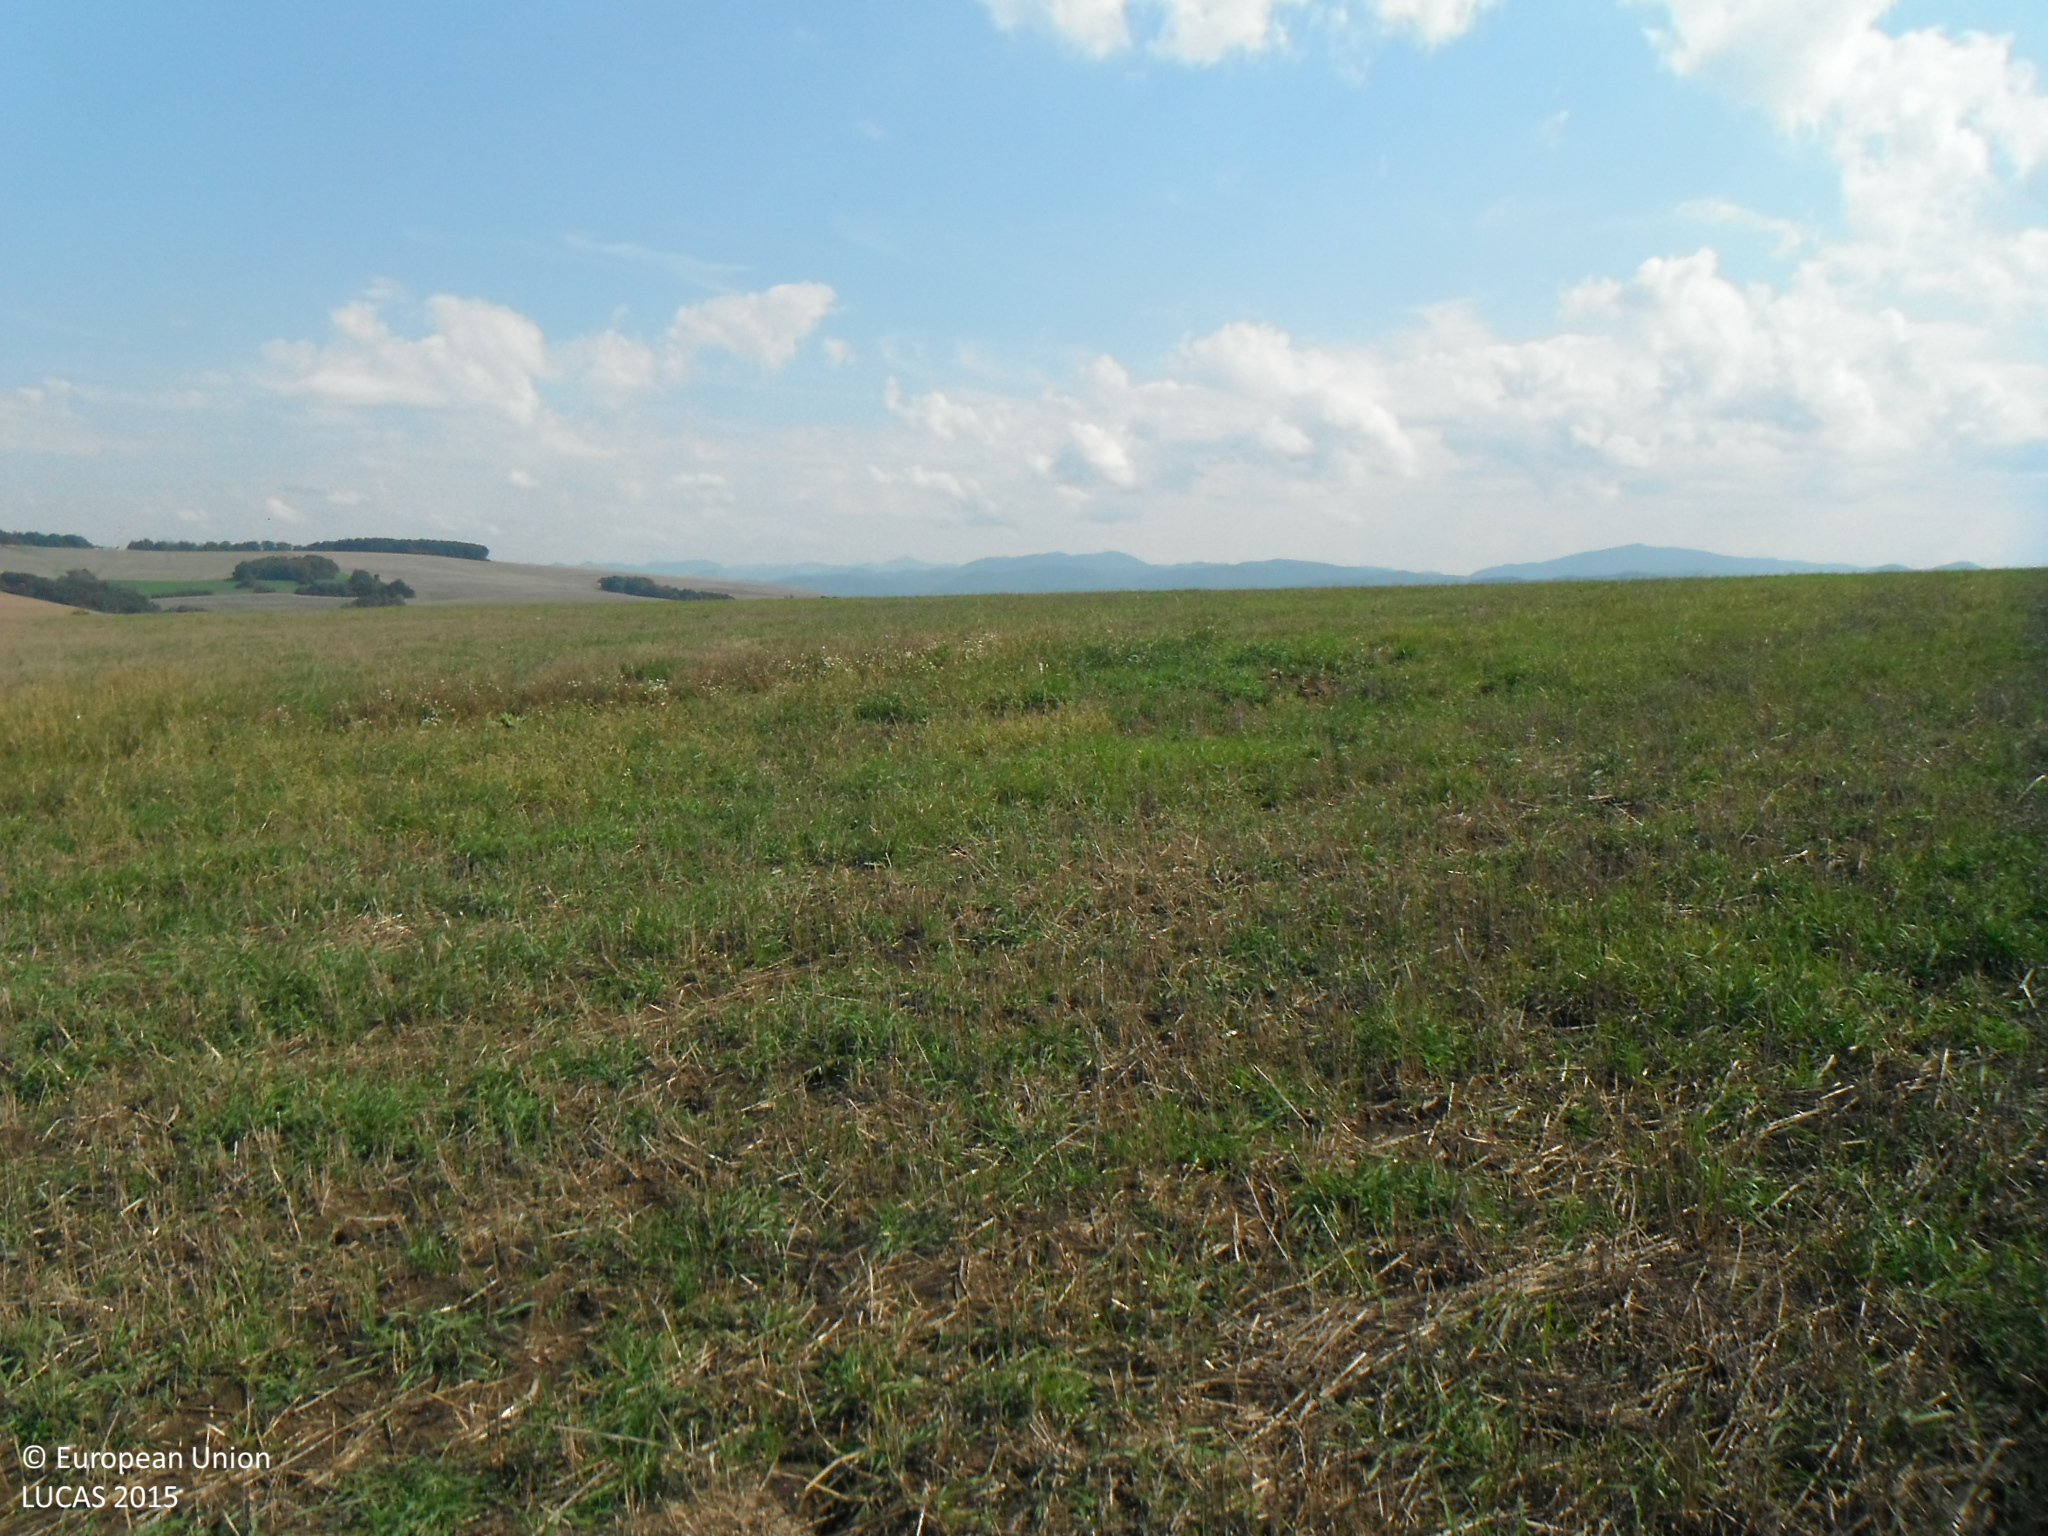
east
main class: Cropland
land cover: Common wheat
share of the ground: < 10 %
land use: Agriculture (excluding fallow land and kitchen gardens)
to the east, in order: Common wheat
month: September
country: SK
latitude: 48.9428
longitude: 18.0289
